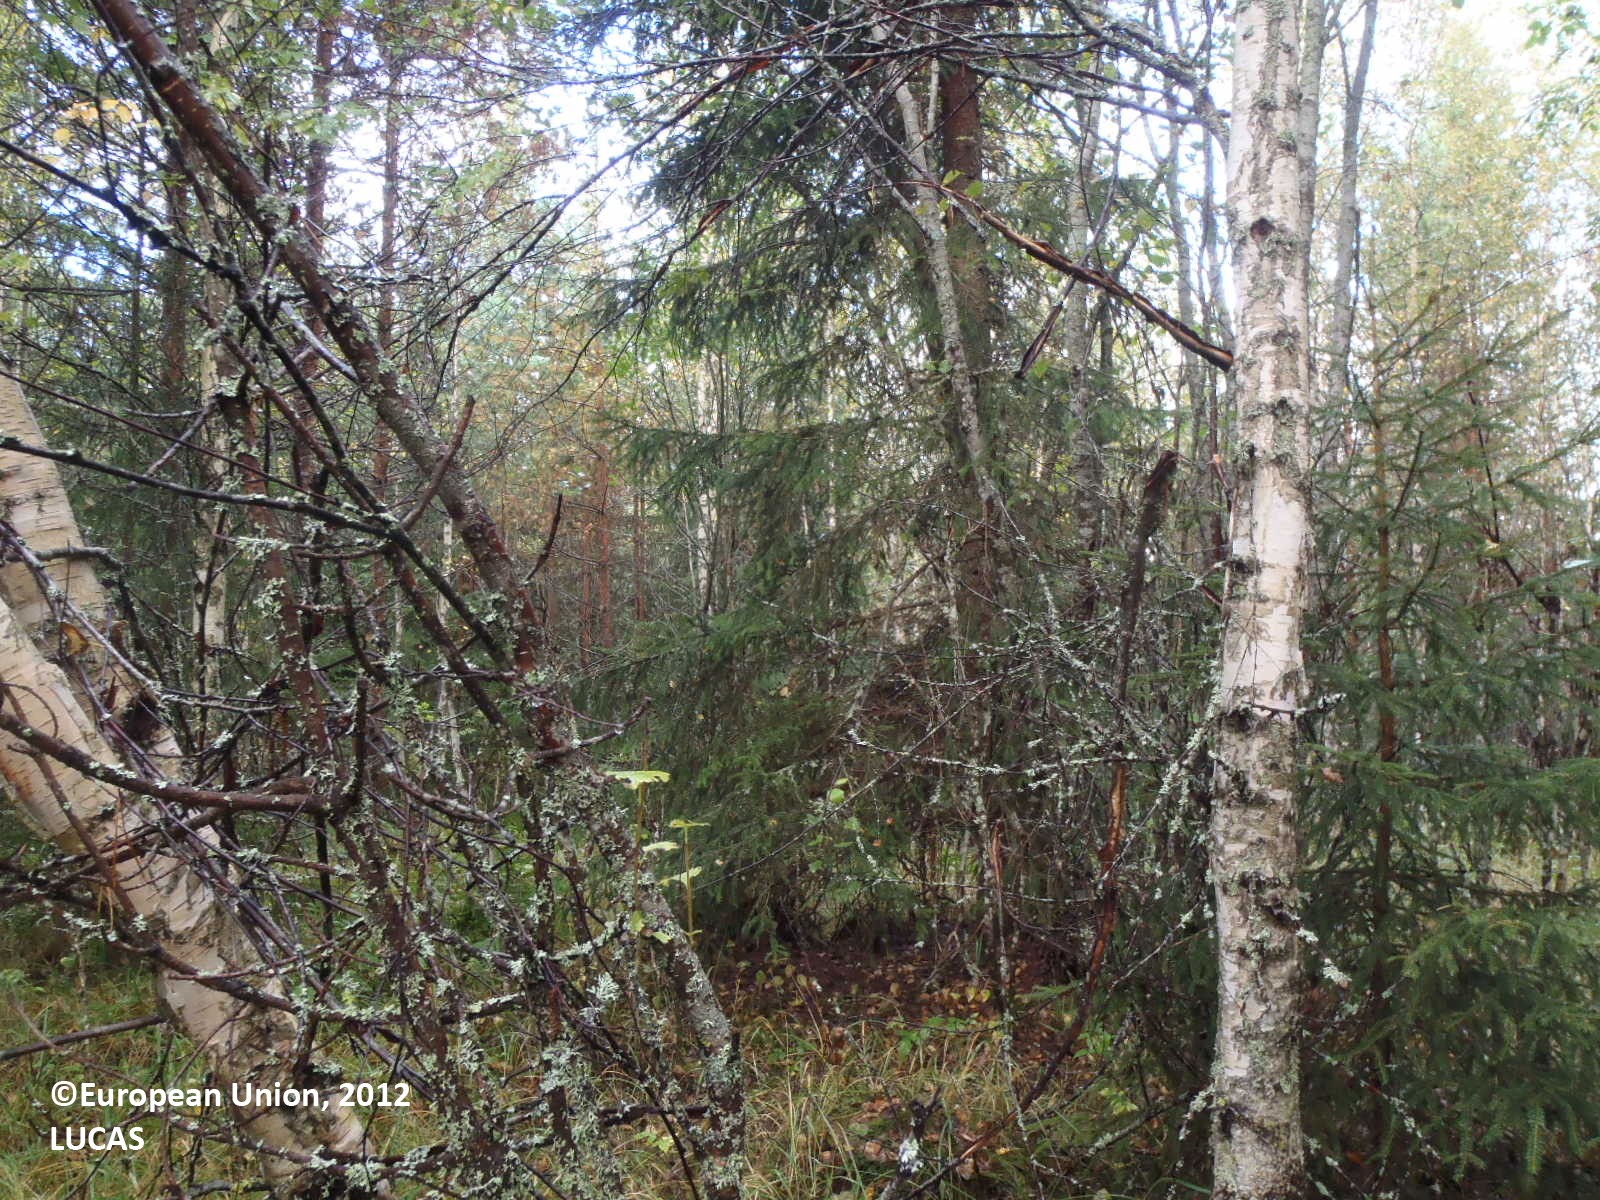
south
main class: Woodland
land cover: Pine dominated mixed woodland
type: boreal forest
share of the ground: > 75 %
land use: Forestry
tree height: > 5 m
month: September
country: FI
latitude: 61.6771
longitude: 22.8205
